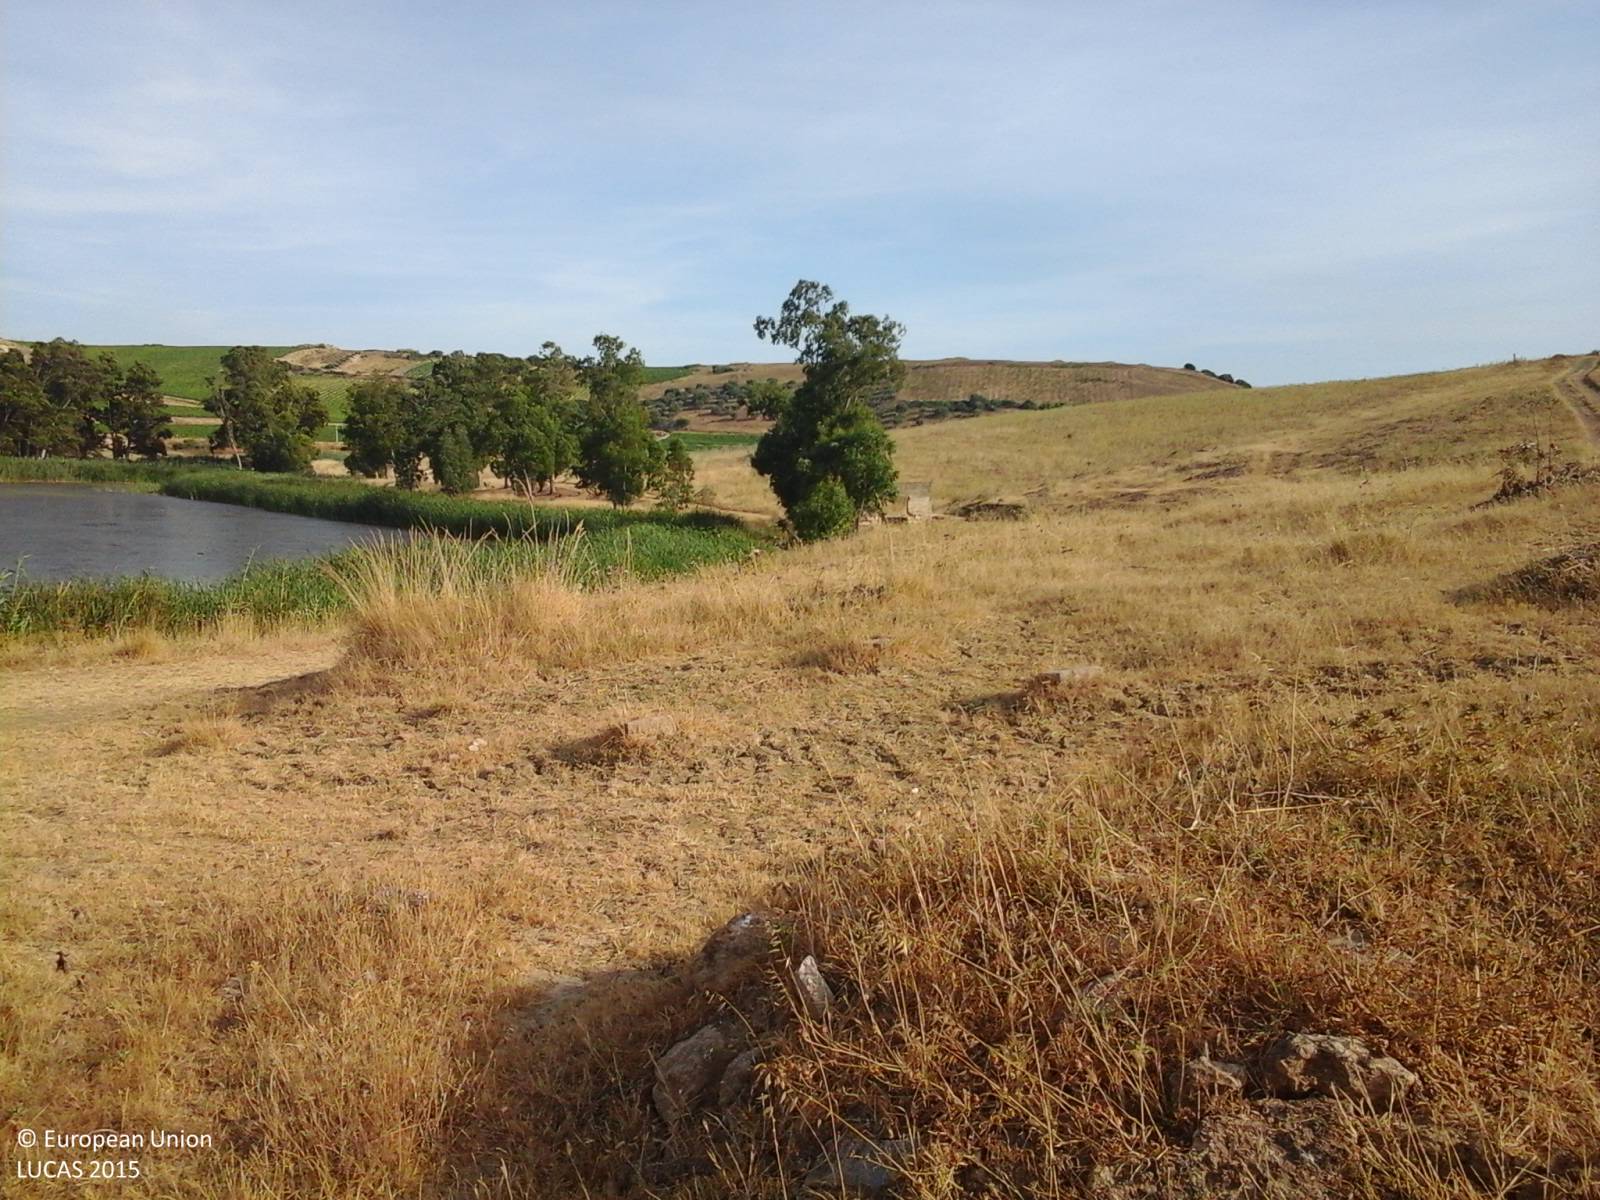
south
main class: Grassland
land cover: Grassland without tree/shrub cover
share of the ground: > 75 %
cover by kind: herbaceous plants 100 %
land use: Agriculture (excluding fallow land and kitchen gardens)
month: June
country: IT
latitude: 37.8033
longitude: 12.5816
